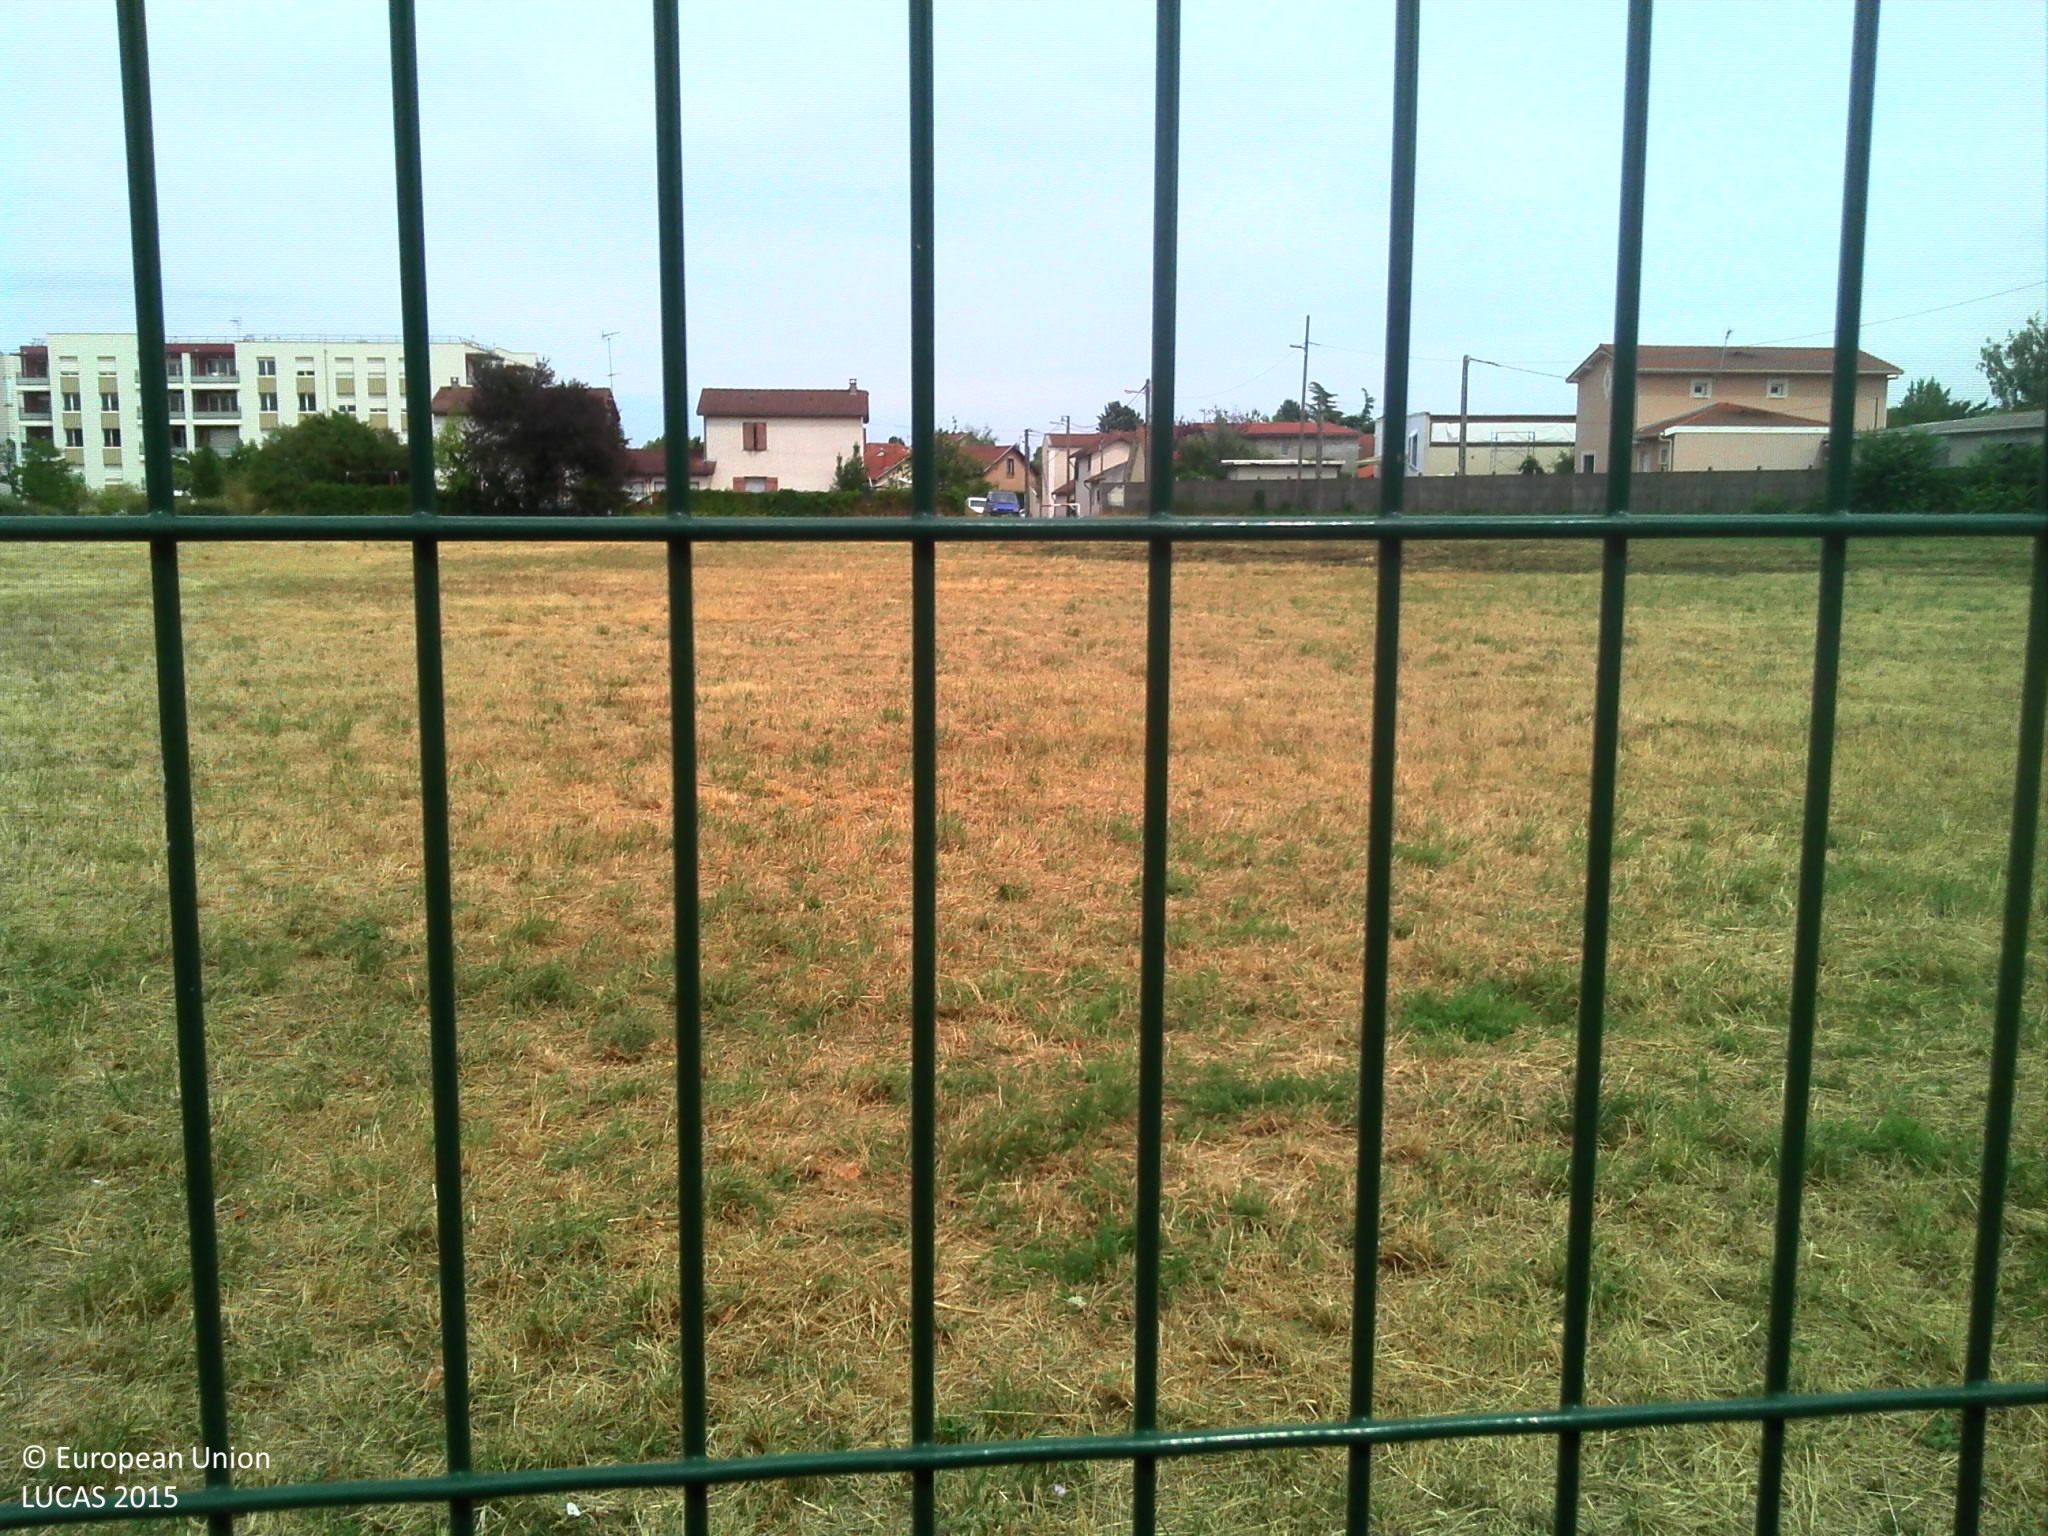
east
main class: Grassland
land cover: Grassland without tree/shrub cover
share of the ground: > 75 %
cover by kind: herbaceous plants 100 %
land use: Amenities, museums, leisure
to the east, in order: Fences; Grassland without tree/shrub cover; Artificial constructions in urban areas
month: July
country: FR
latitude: 45.7435
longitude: 4.9267
